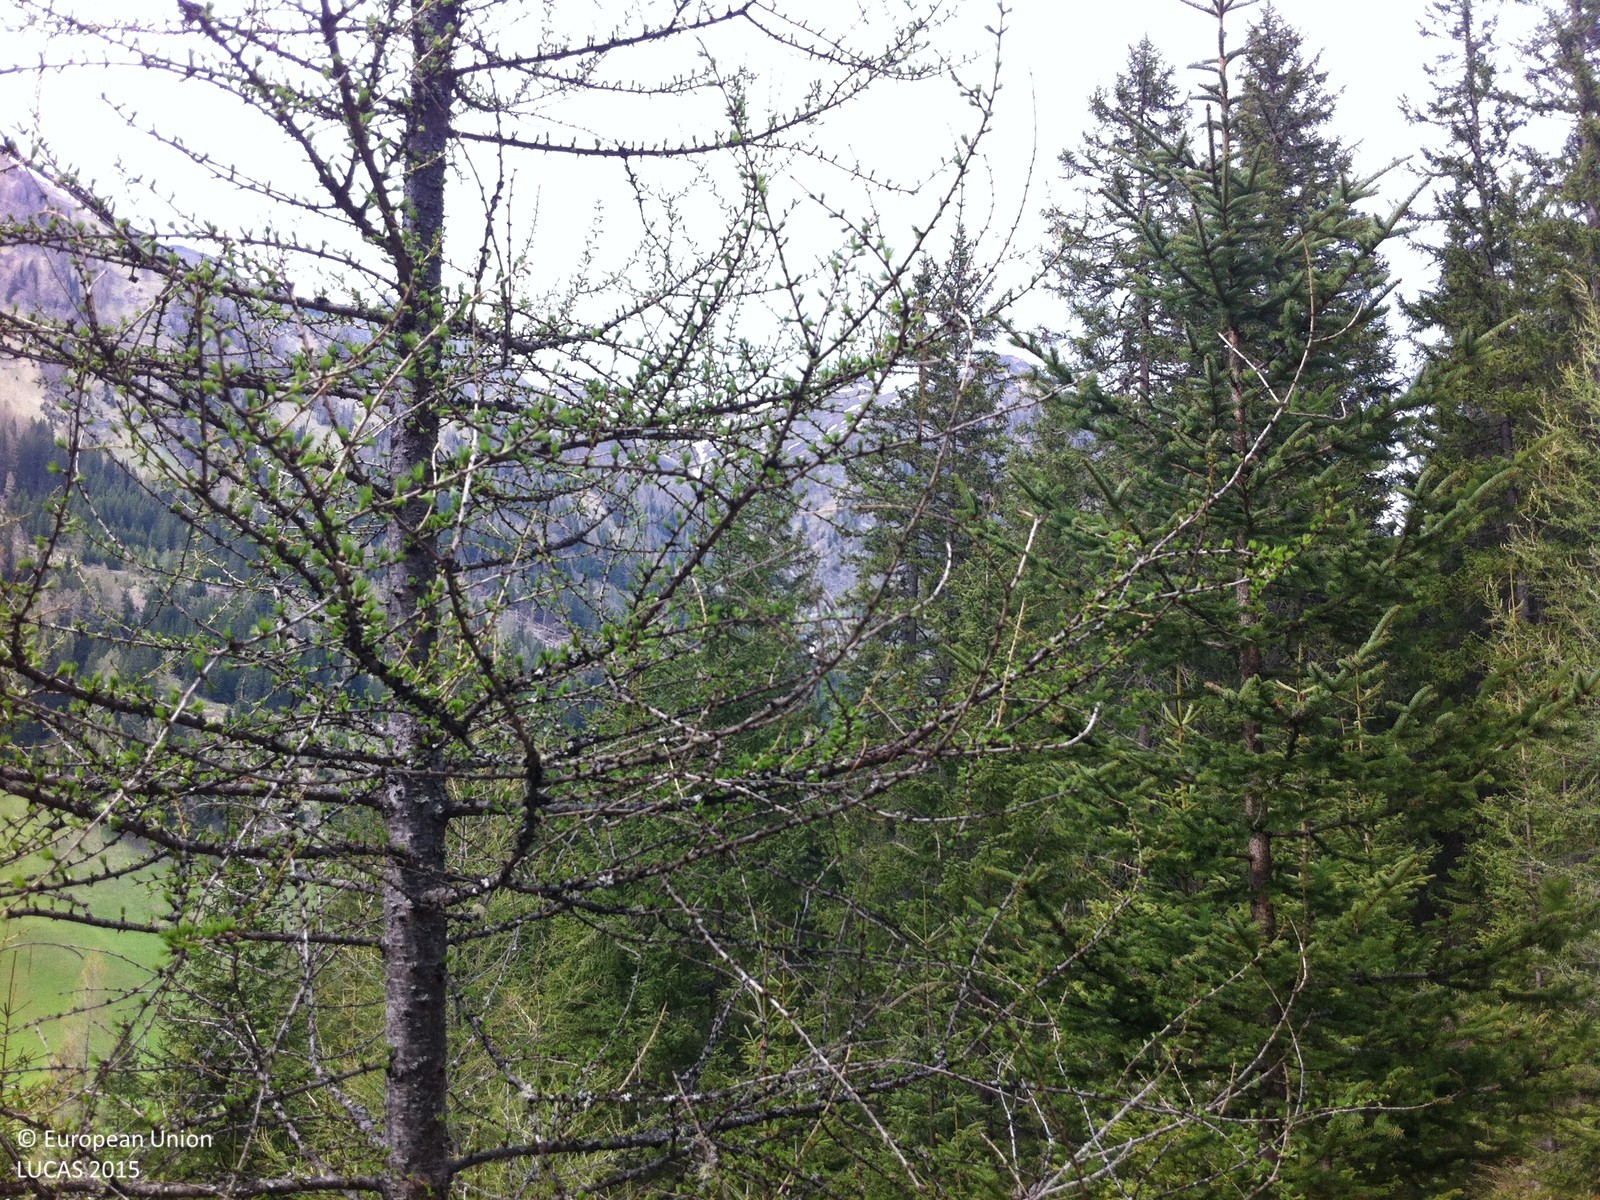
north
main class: Woodland
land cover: Spruce dominated coniferous woodland
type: alpine coniferous forest
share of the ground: 50 - 75 %
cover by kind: coniferous forest trees 55 %, herbaceous plants 25 %, lichens and mosses 20 %
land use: Forestry
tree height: < 5 m
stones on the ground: < 10 %
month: May
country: AT
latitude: 47.0782
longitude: 11.5658
